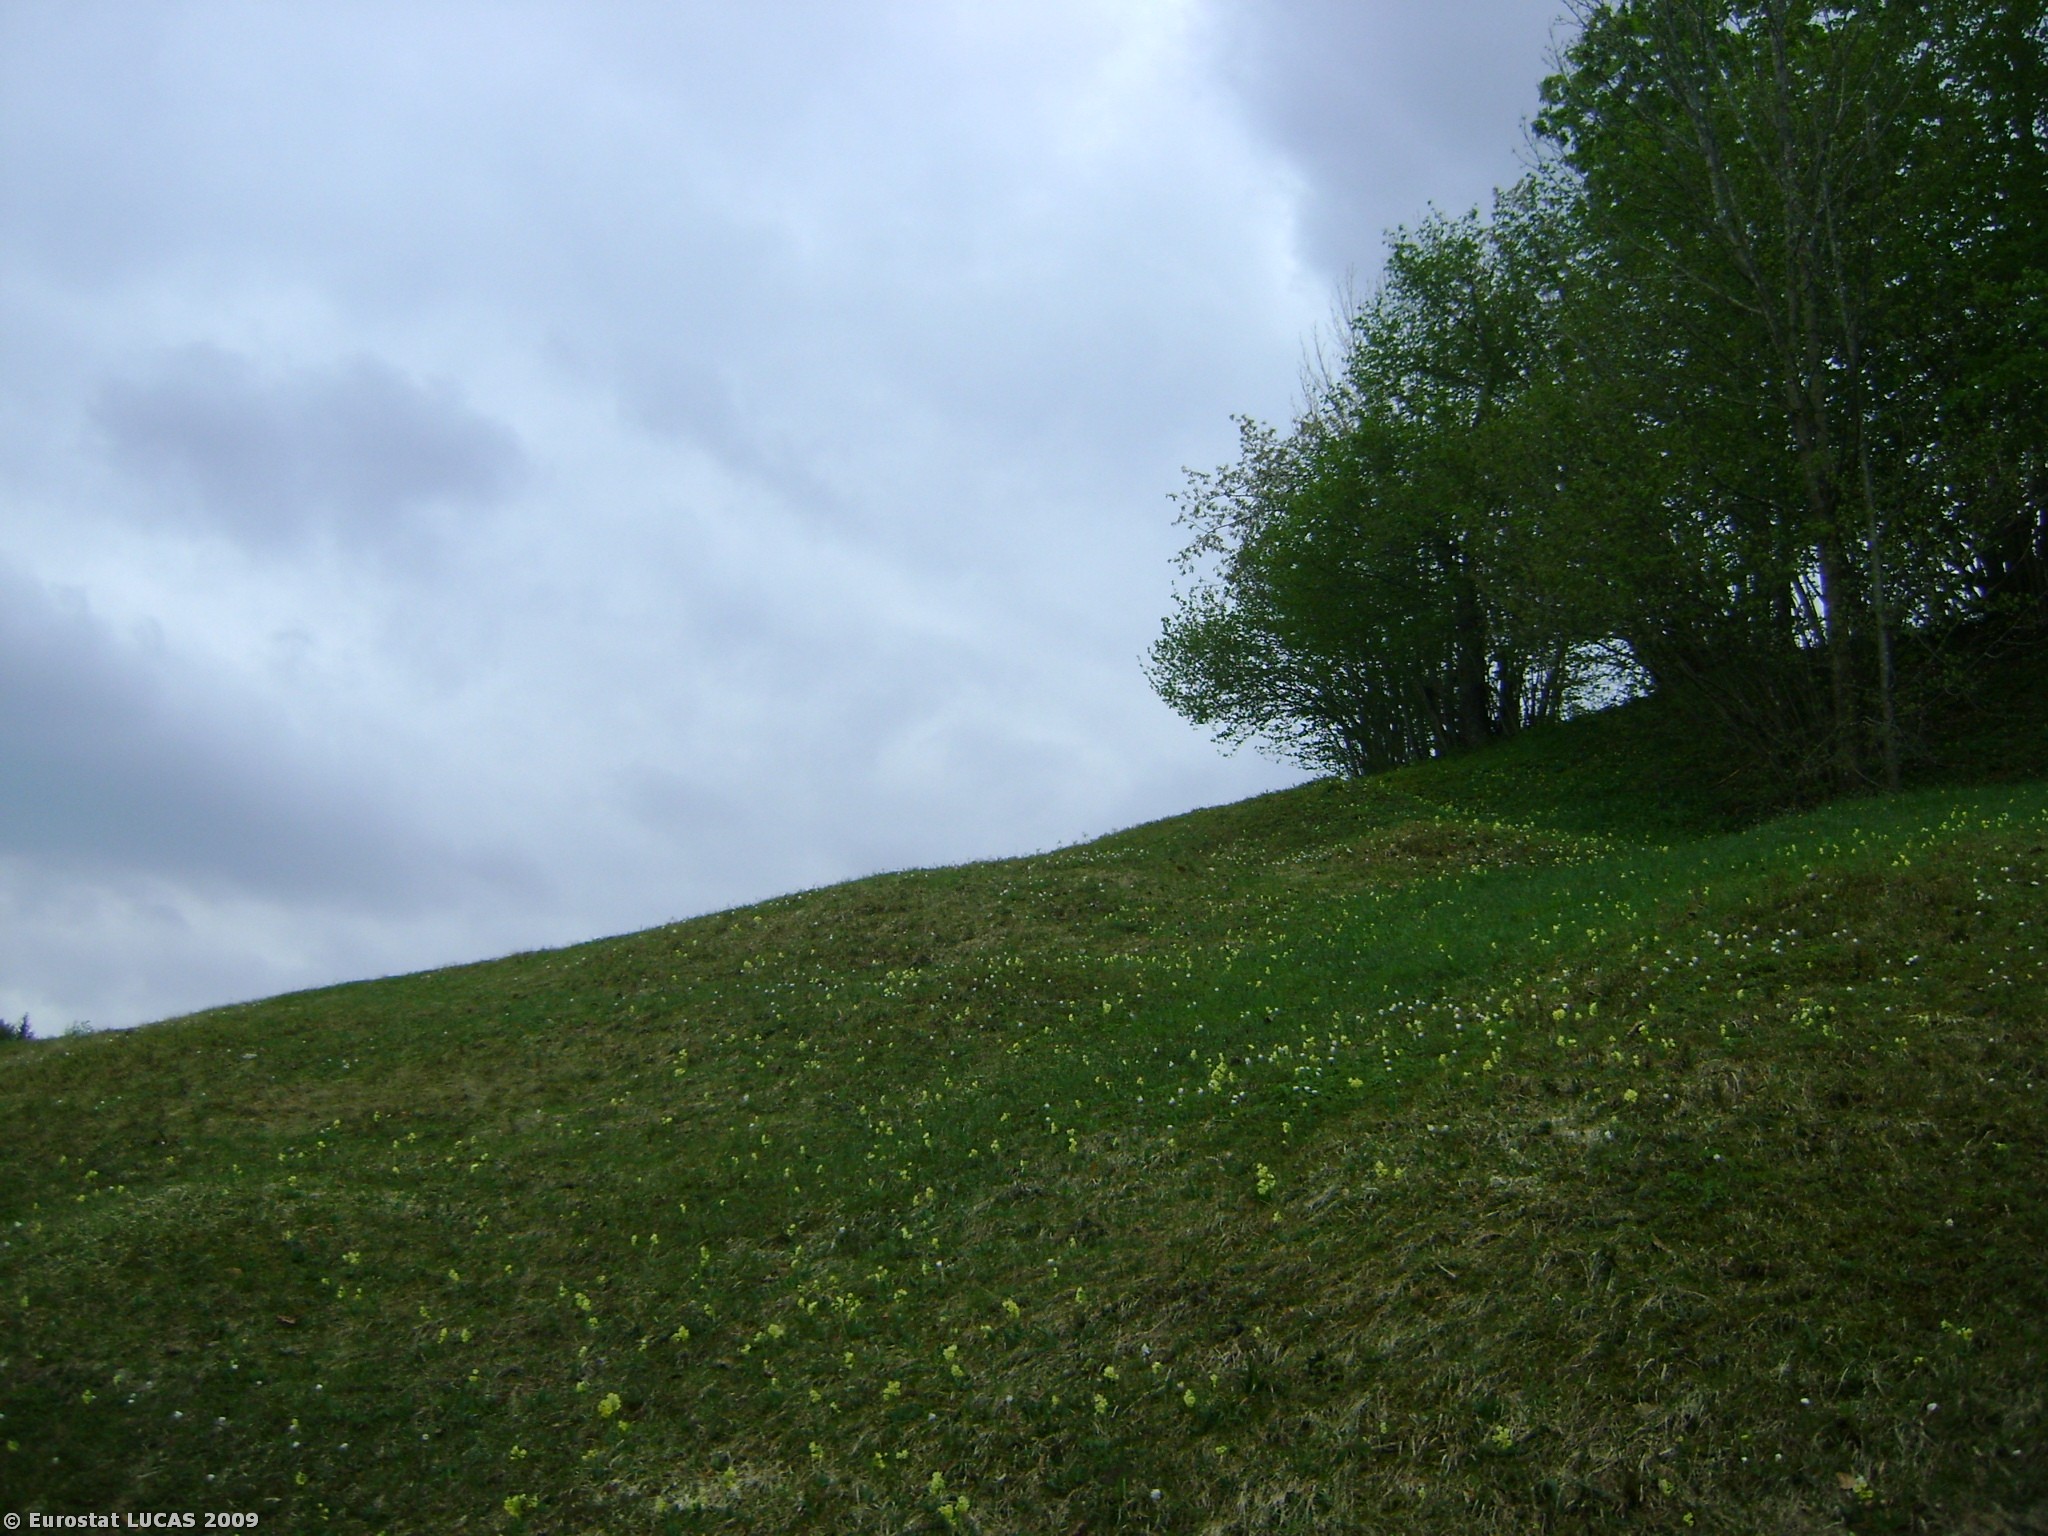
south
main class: Grassland
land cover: Grassland without tree/shrub cover
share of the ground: > 75 %
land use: Agriculture (excluding fallow land and kitchen gardens)
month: May
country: AT
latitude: 47.7625
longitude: 13.2140
